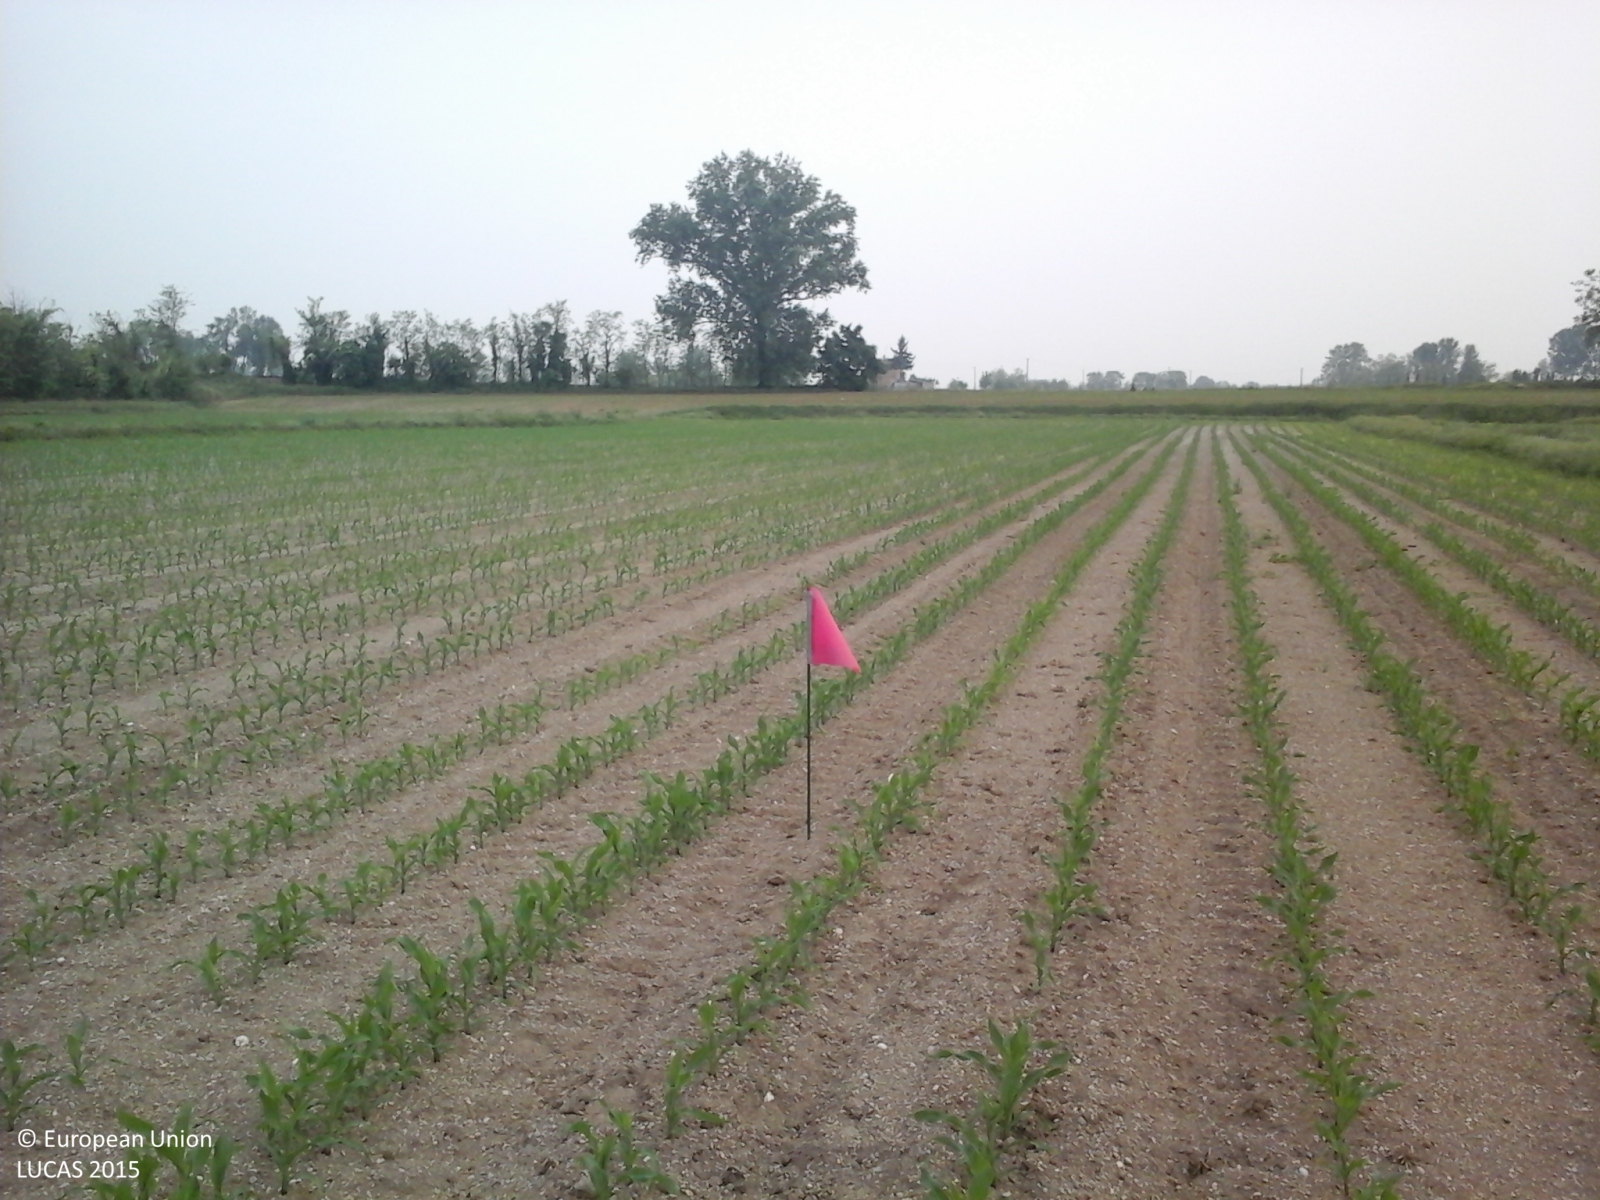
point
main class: Cropland
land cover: Maize
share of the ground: 10 - 25 %
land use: Agriculture (excluding fallow land and kitchen gardens)
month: May
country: IT
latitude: 45.1973
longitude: 10.3939
